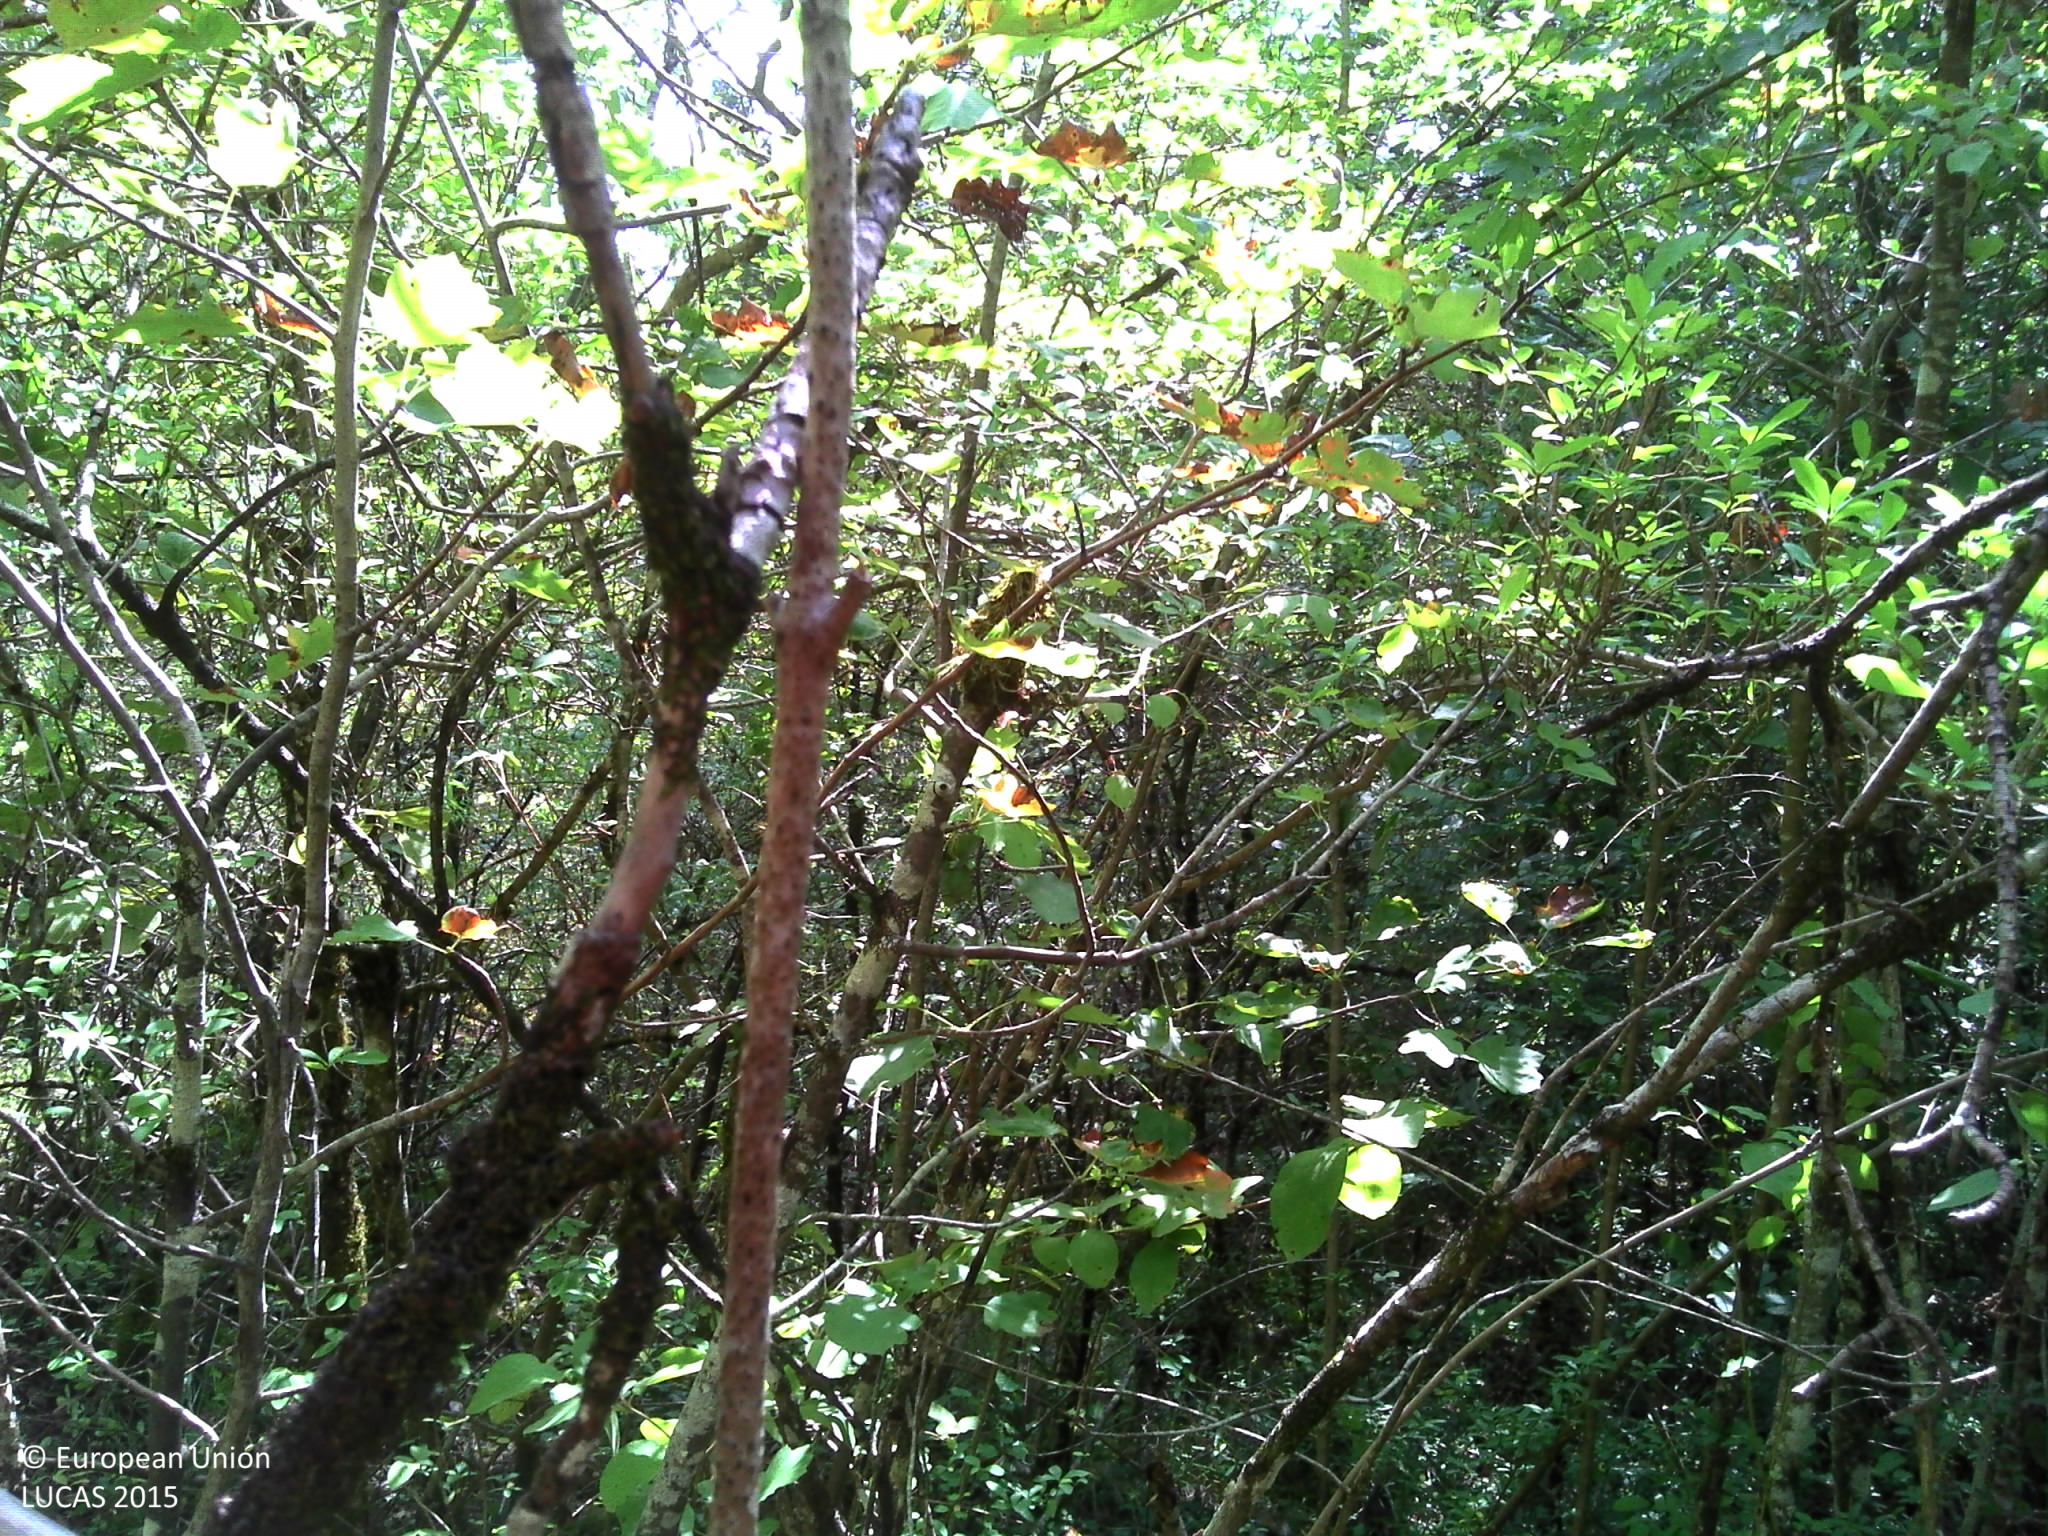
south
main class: Woodland
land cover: Pine dominated mixed woodland
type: hemiboreal forest and nemoral coniferous forest and mixed broadleaved-coniferous forest
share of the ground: > 75 %
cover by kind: broadleaved forest trees 60 %, coniferous forest trees 25 %, herbaceous plants 10 %, lichens and mosses 5 %
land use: Forestry
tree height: > 5 m
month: August
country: FR
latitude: 47.7278
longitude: 4.9197
